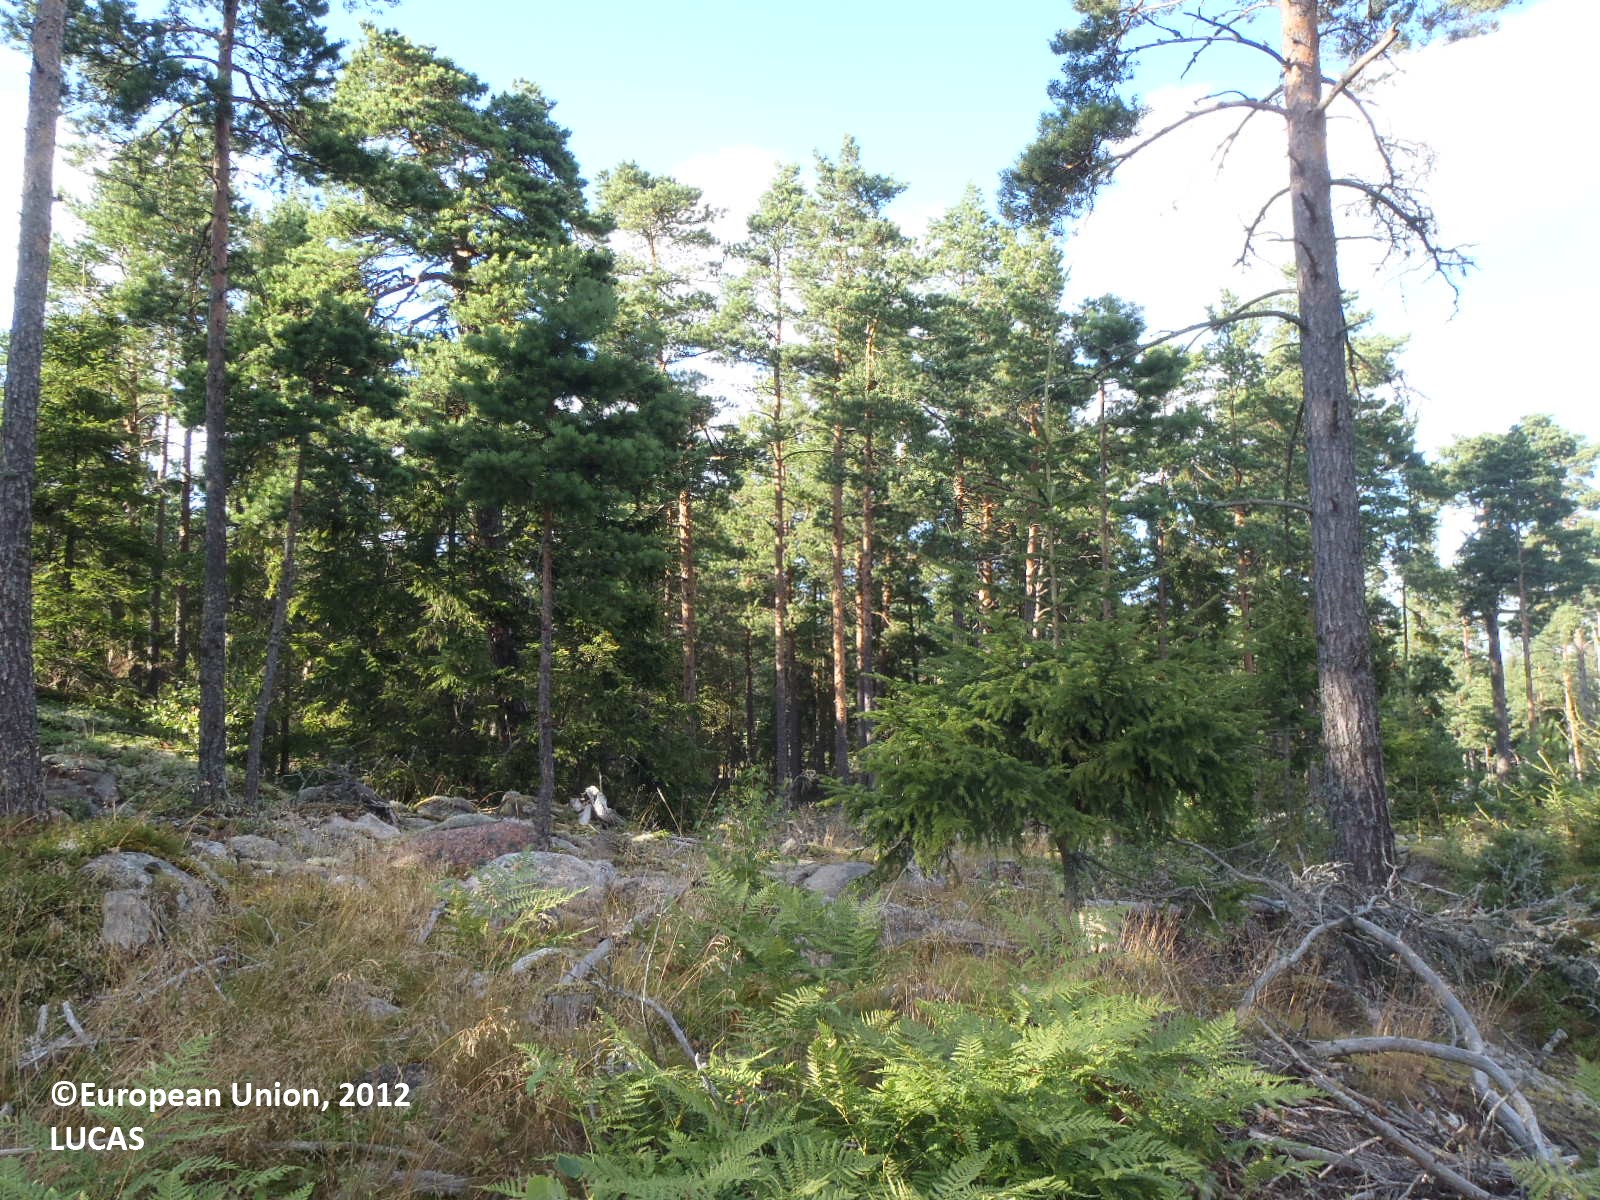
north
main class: Woodland
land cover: Pine dominated mixed woodland
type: boreal forest
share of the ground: 10 - 25 %
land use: Forestry
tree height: > 5 m
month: August
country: FI
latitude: 60.1257
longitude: 21.5242
